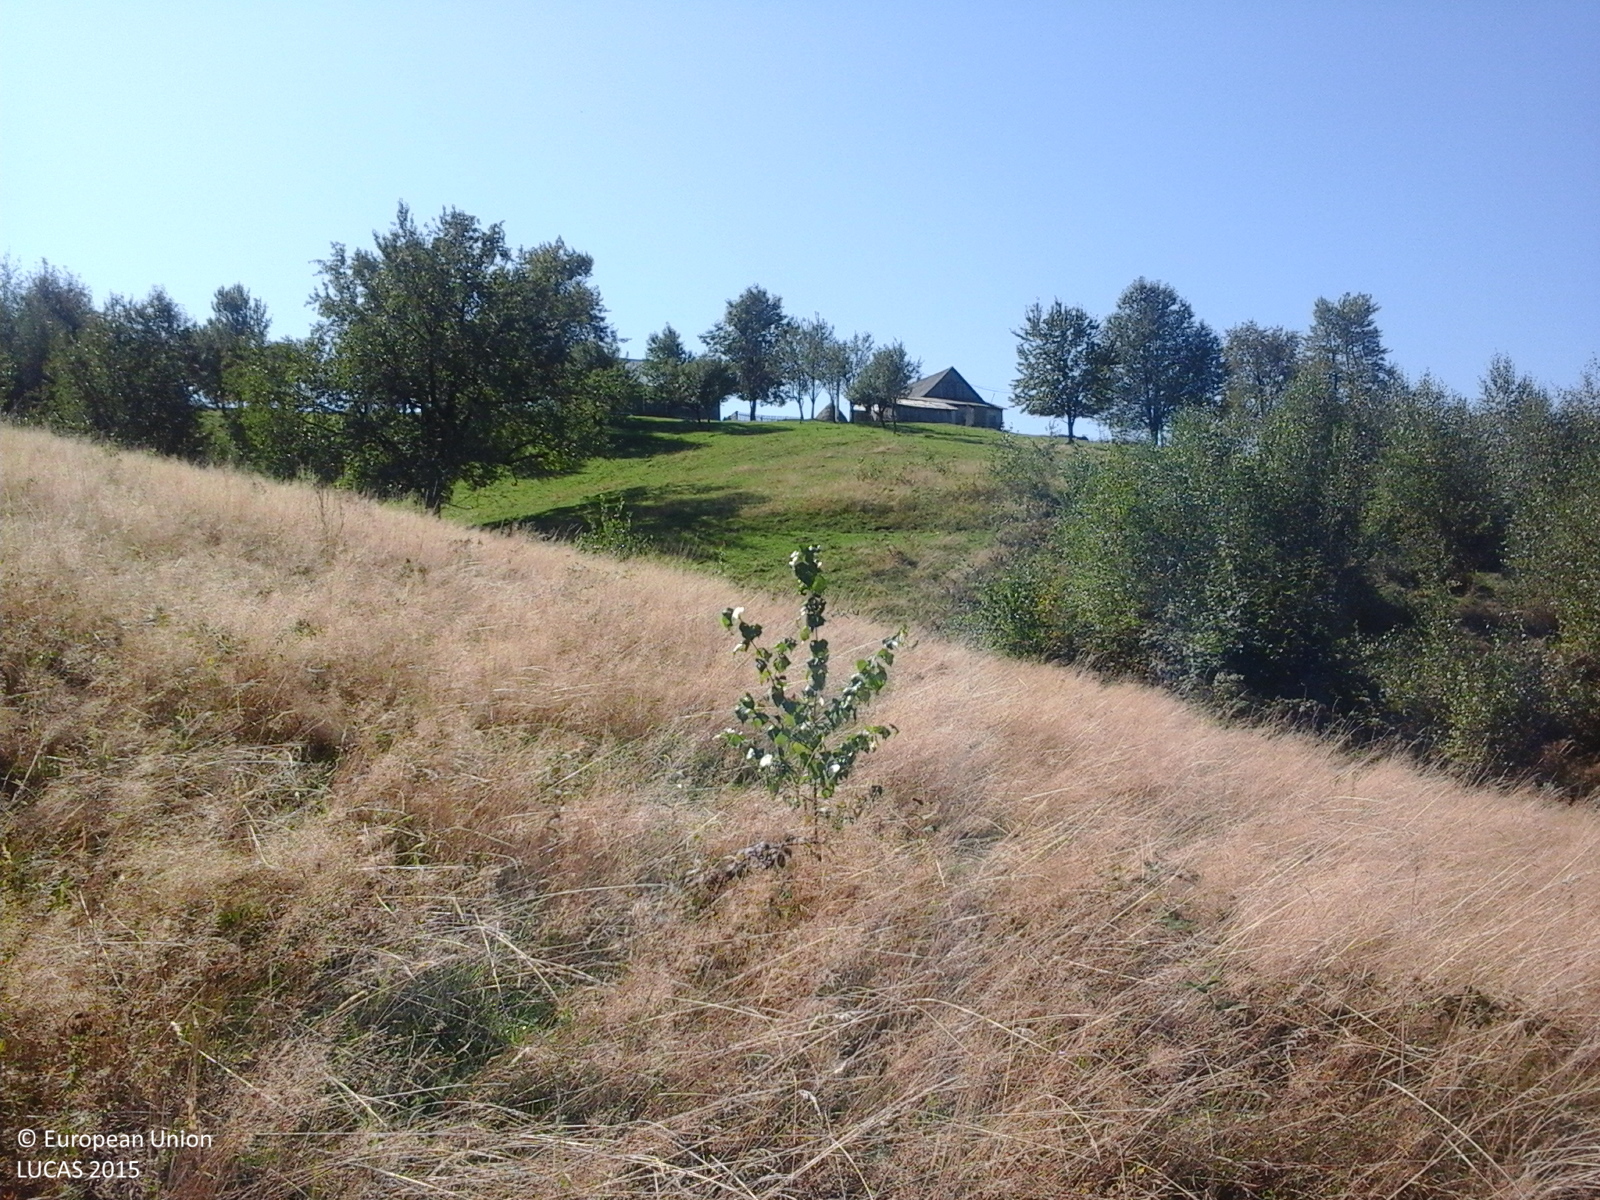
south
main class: Grassland
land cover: Grassland with sparse tree/shrub cover
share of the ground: > 75 %
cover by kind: herbaceous plants 85 %, shrubs 10 %, broadleaved forest trees 5 %
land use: Agriculture (excluding fallow land and kitchen gardens)
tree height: < 5 m
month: September
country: RO
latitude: 47.1043
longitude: 22.5338
